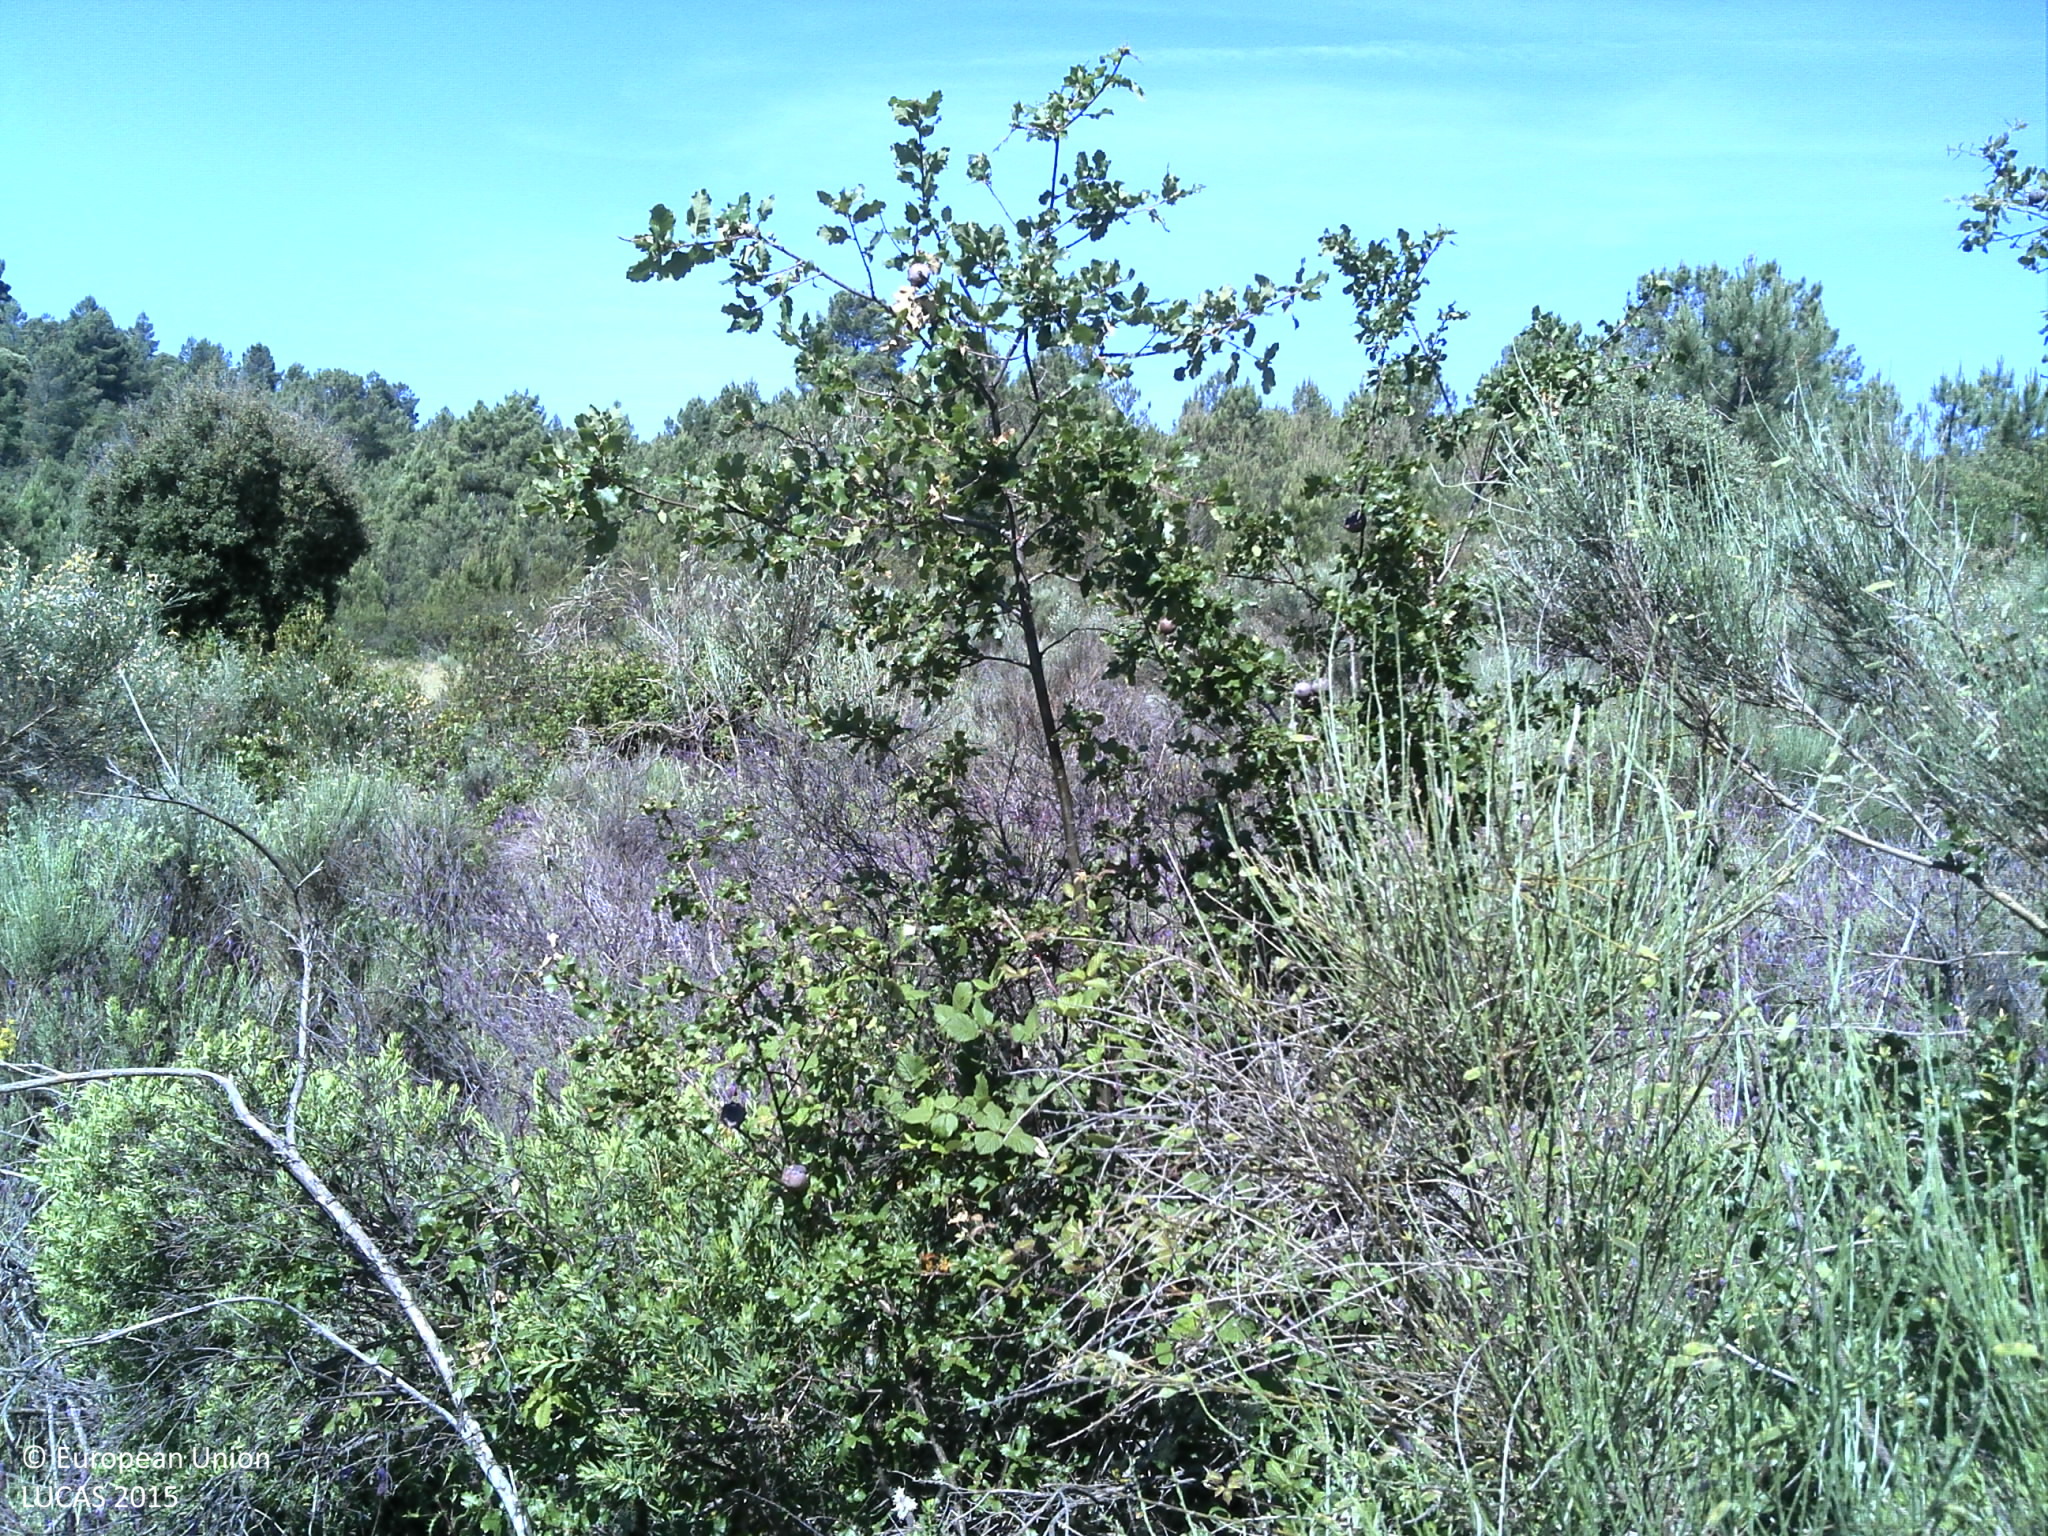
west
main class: Shrubland
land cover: Shrubland with sparse tree cover
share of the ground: > 75 %
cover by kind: shrubs 95 %, broadleaved forest trees 5 %
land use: Abandoned areas
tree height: > 5 m
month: May
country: PT
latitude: 41.1218
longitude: -6.8391
